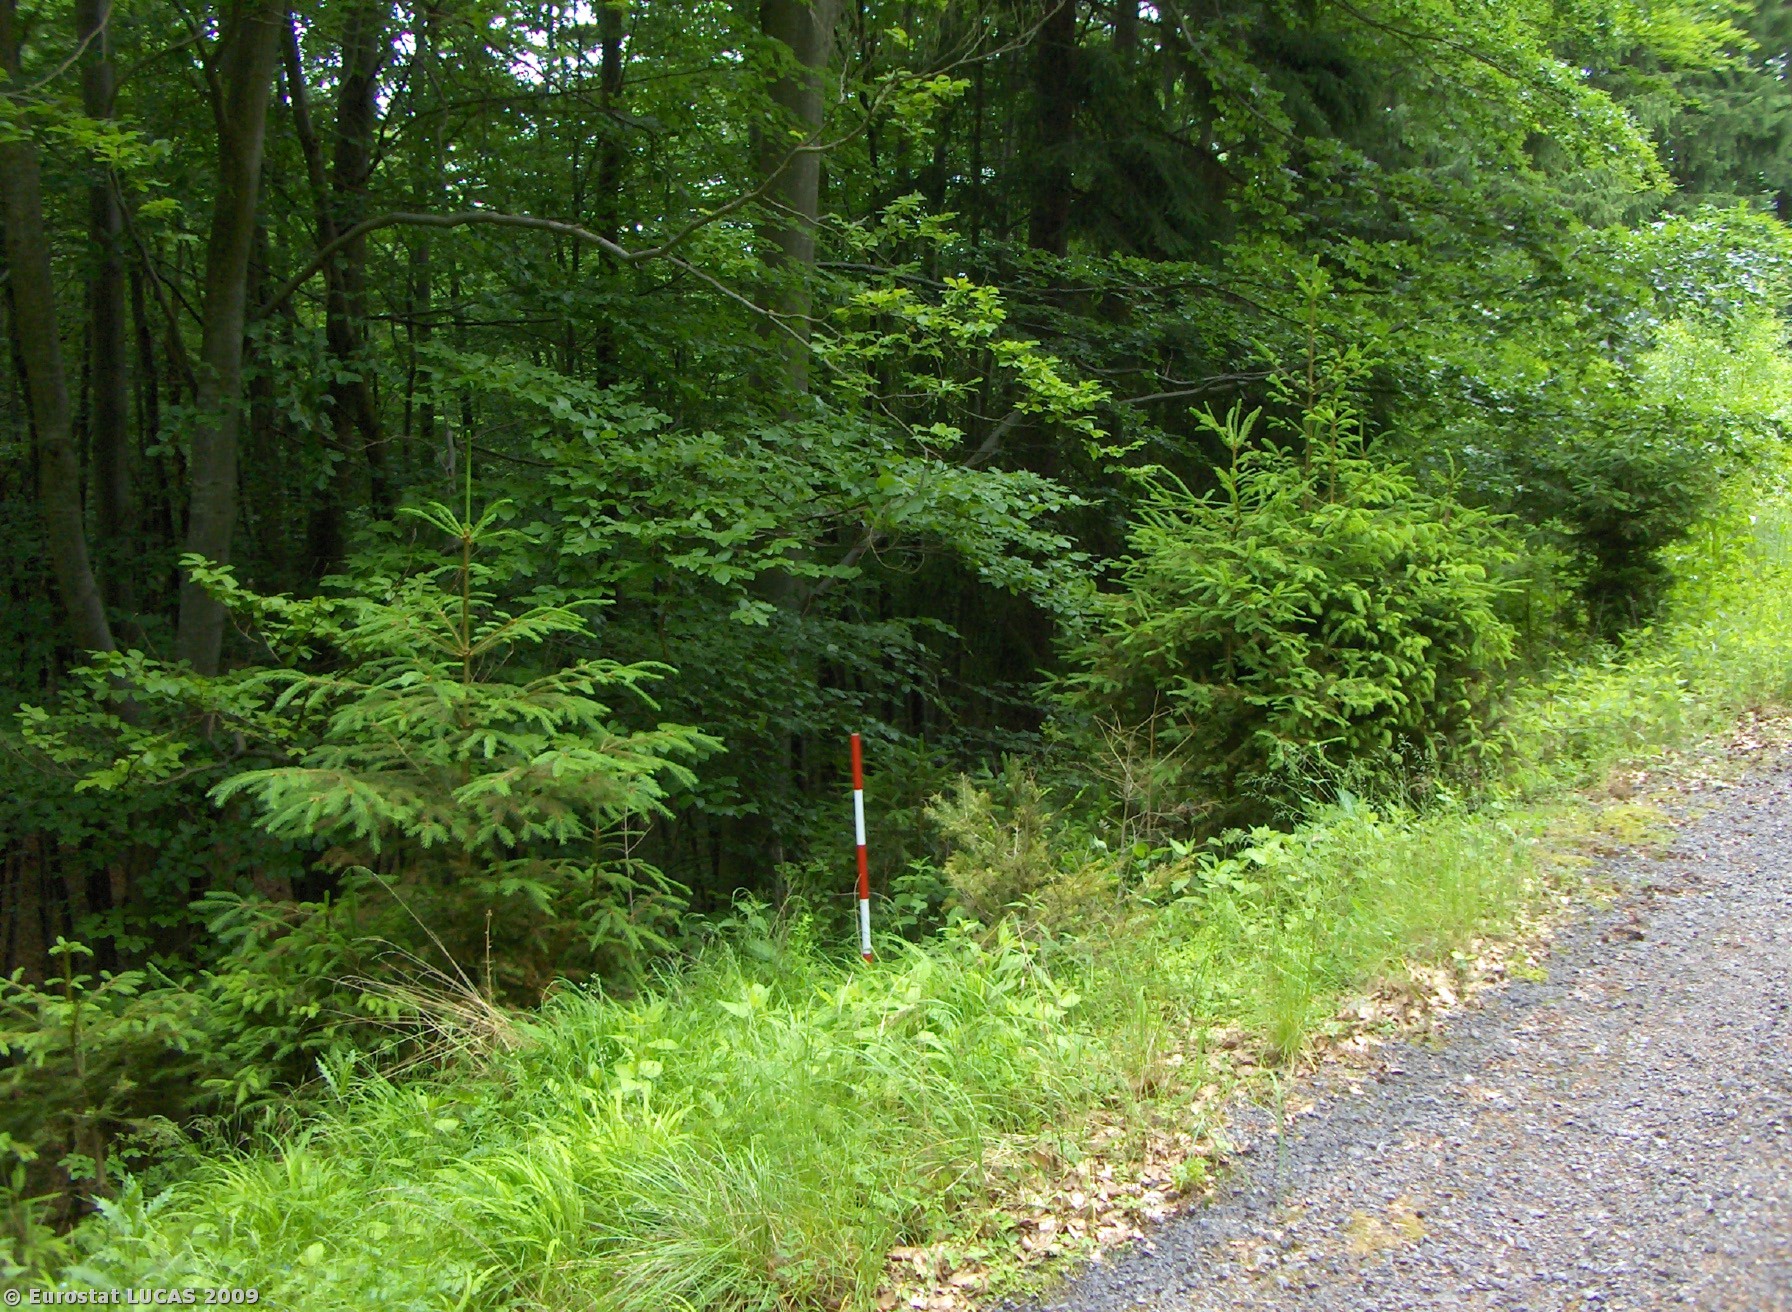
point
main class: Woodland
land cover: Mixed woodland
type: hemiboreal forest and nemoral coniferous forest and mixed broadleaved-coniferous forest
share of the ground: > 75 %
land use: Forestry
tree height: > 5 m
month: May
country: CZ
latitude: 49.1066
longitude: 14.4531
